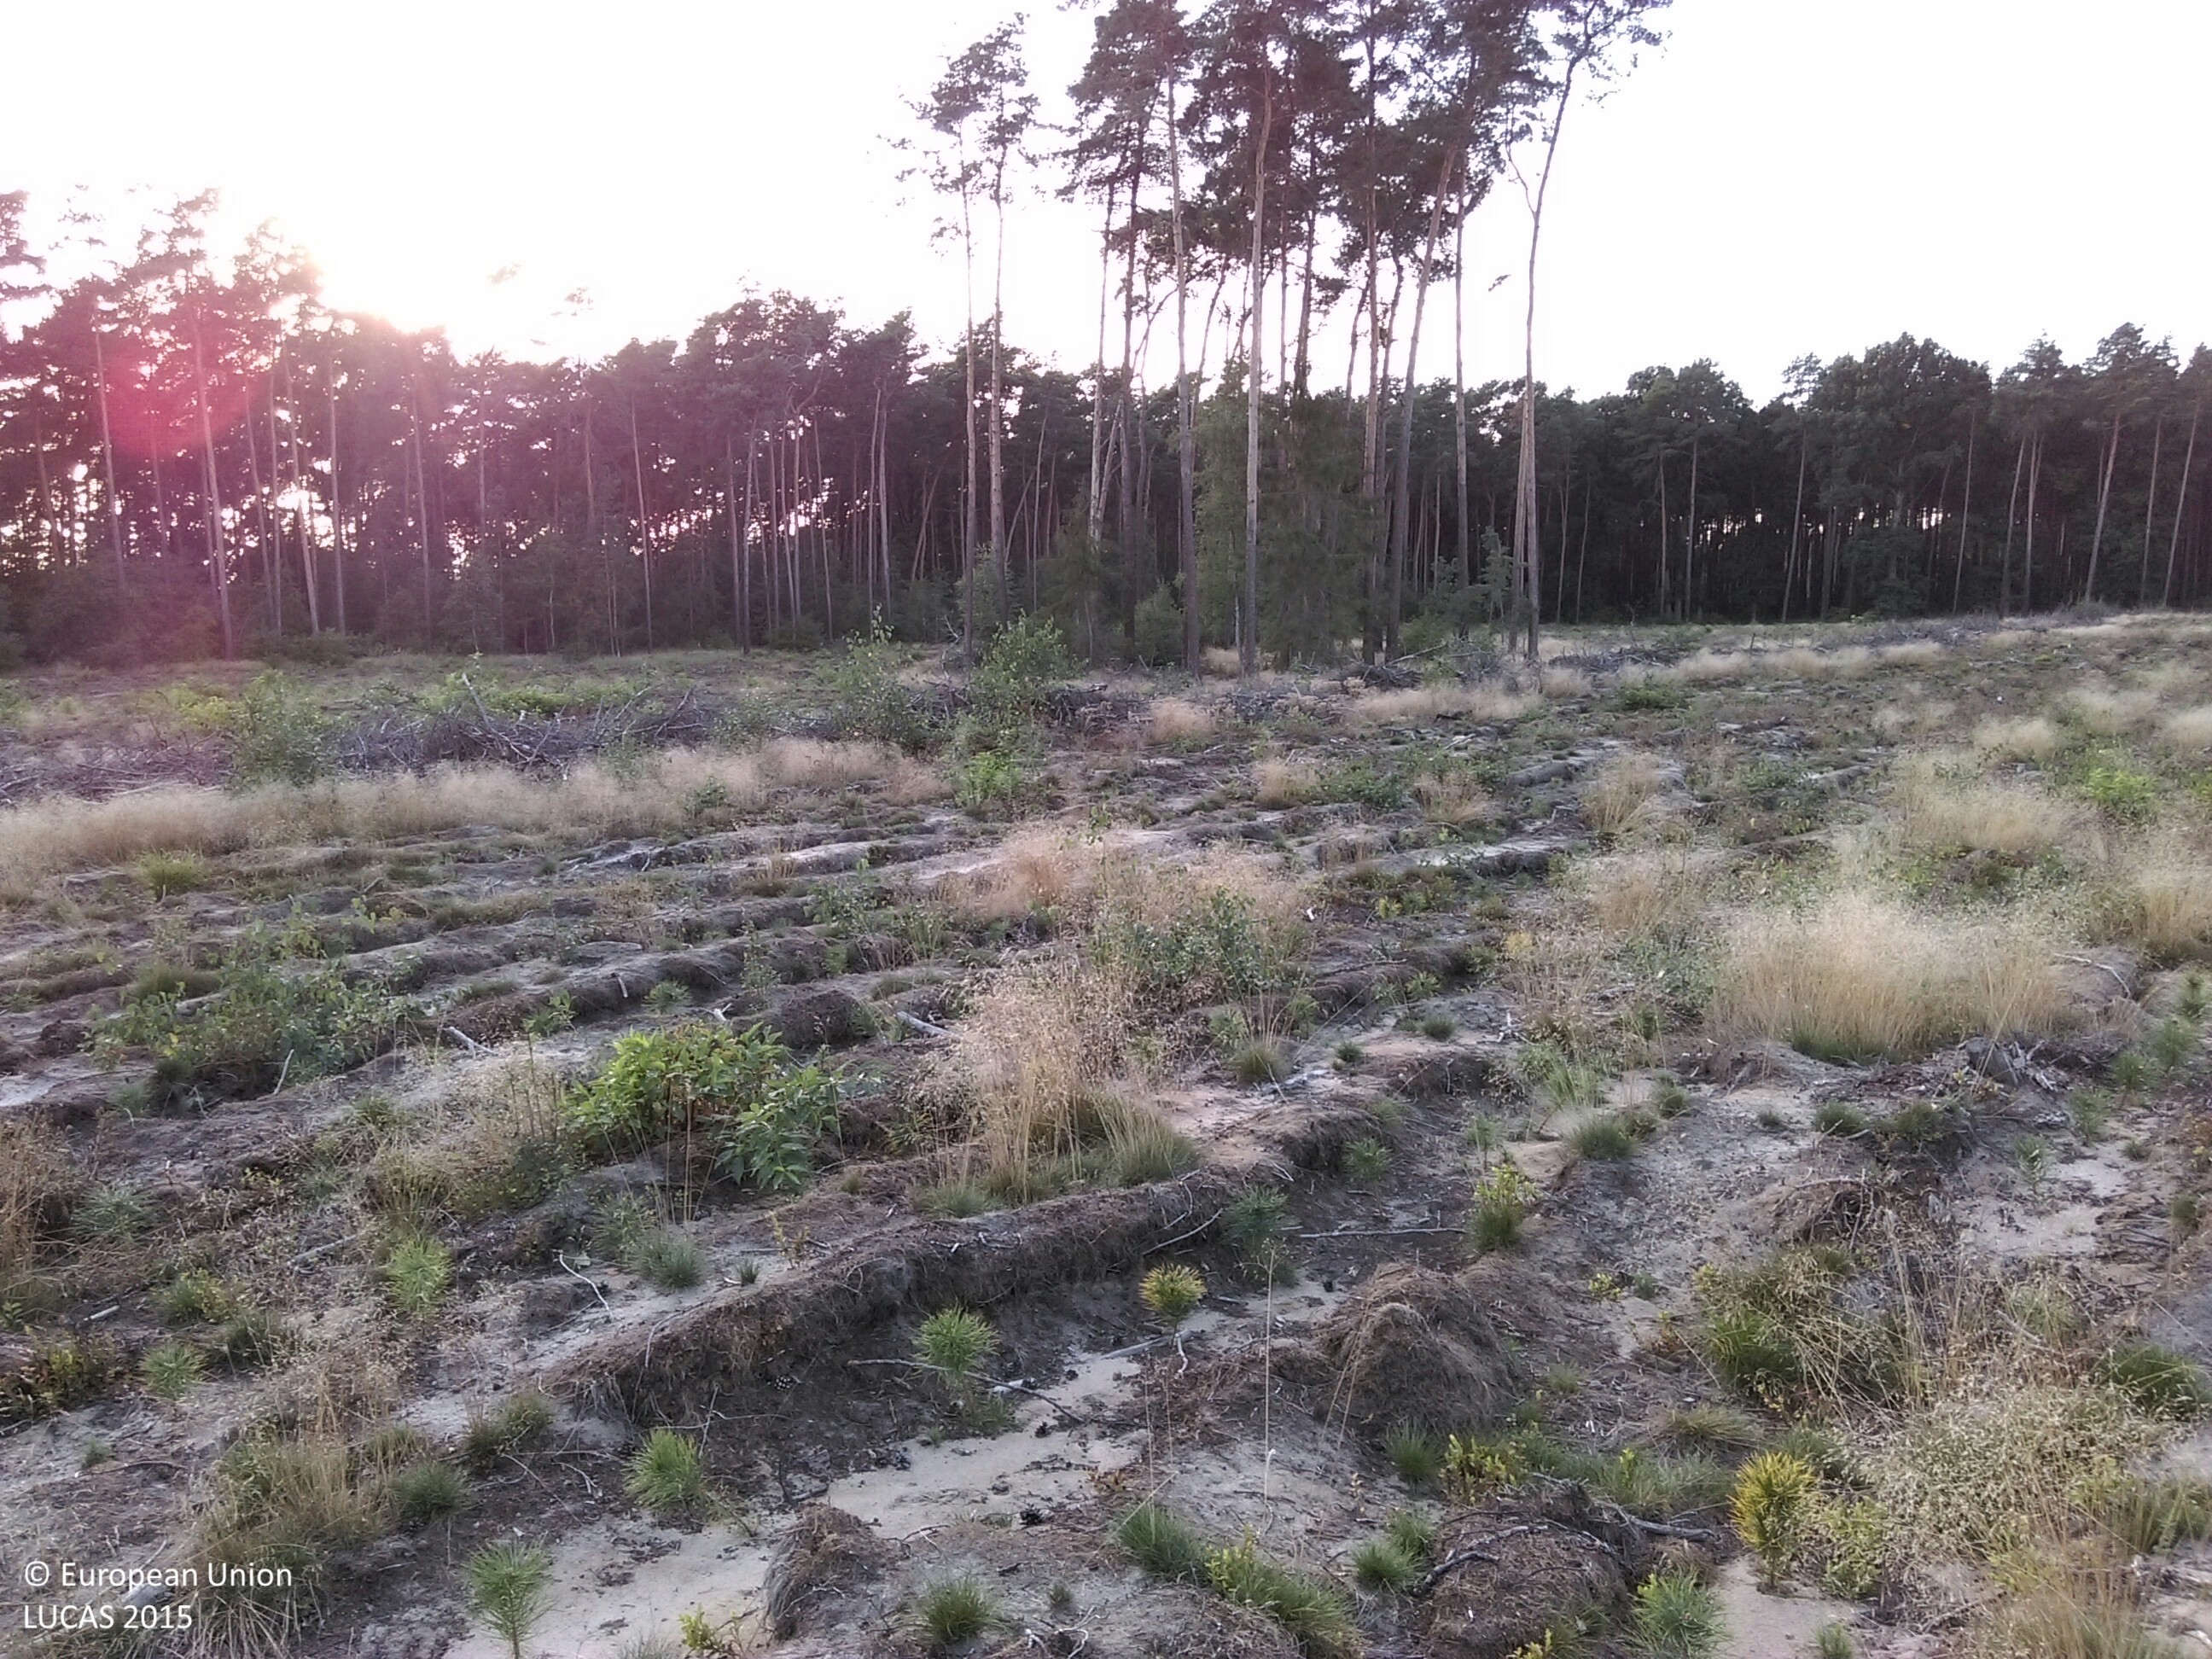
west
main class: Woodland
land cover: Pine dominated coniferous woodland
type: hemiboreal forest and nemoral coniferous forest and mixed broadleaved-coniferous forest
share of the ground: 10 - 25 %
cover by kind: herbaceous plants 50 %, unconsolidated bare surface 30 %, coniferous forest trees 20 %
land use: Forestry
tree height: < 5 m
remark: Clear cut
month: September
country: PL
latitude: 52.1588
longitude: 16.2484
